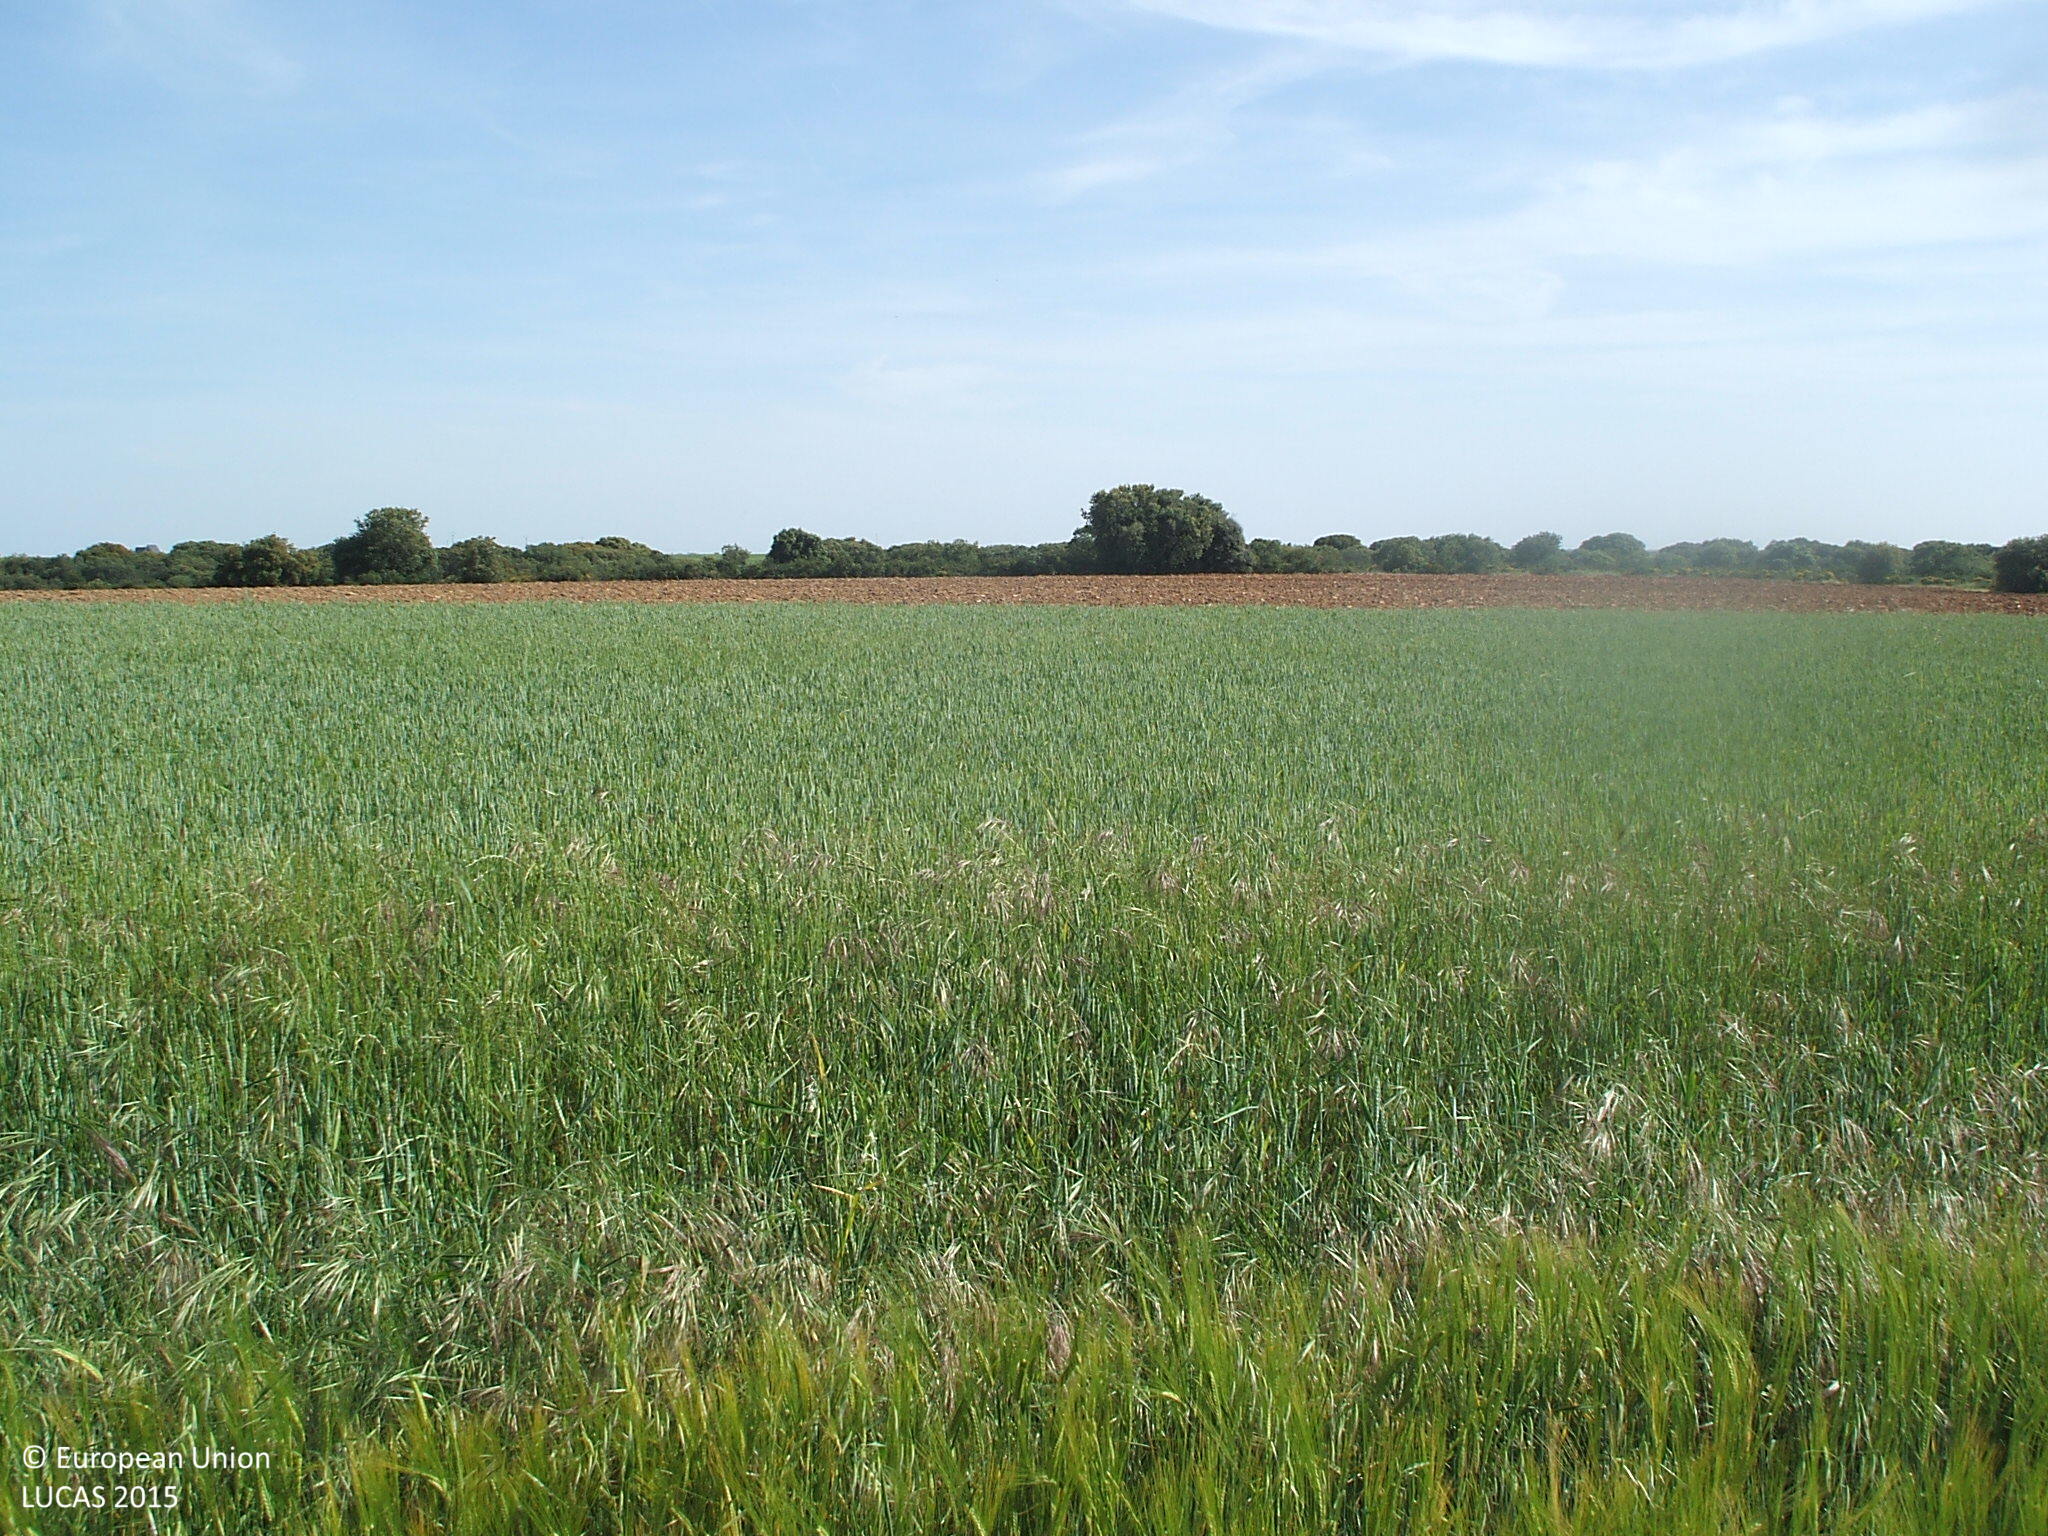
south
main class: Cropland
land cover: Barley
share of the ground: > 75 %
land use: Agriculture (excluding fallow land and kitchen gardens)
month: May
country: ES
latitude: 40.7728
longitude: -3.3905
